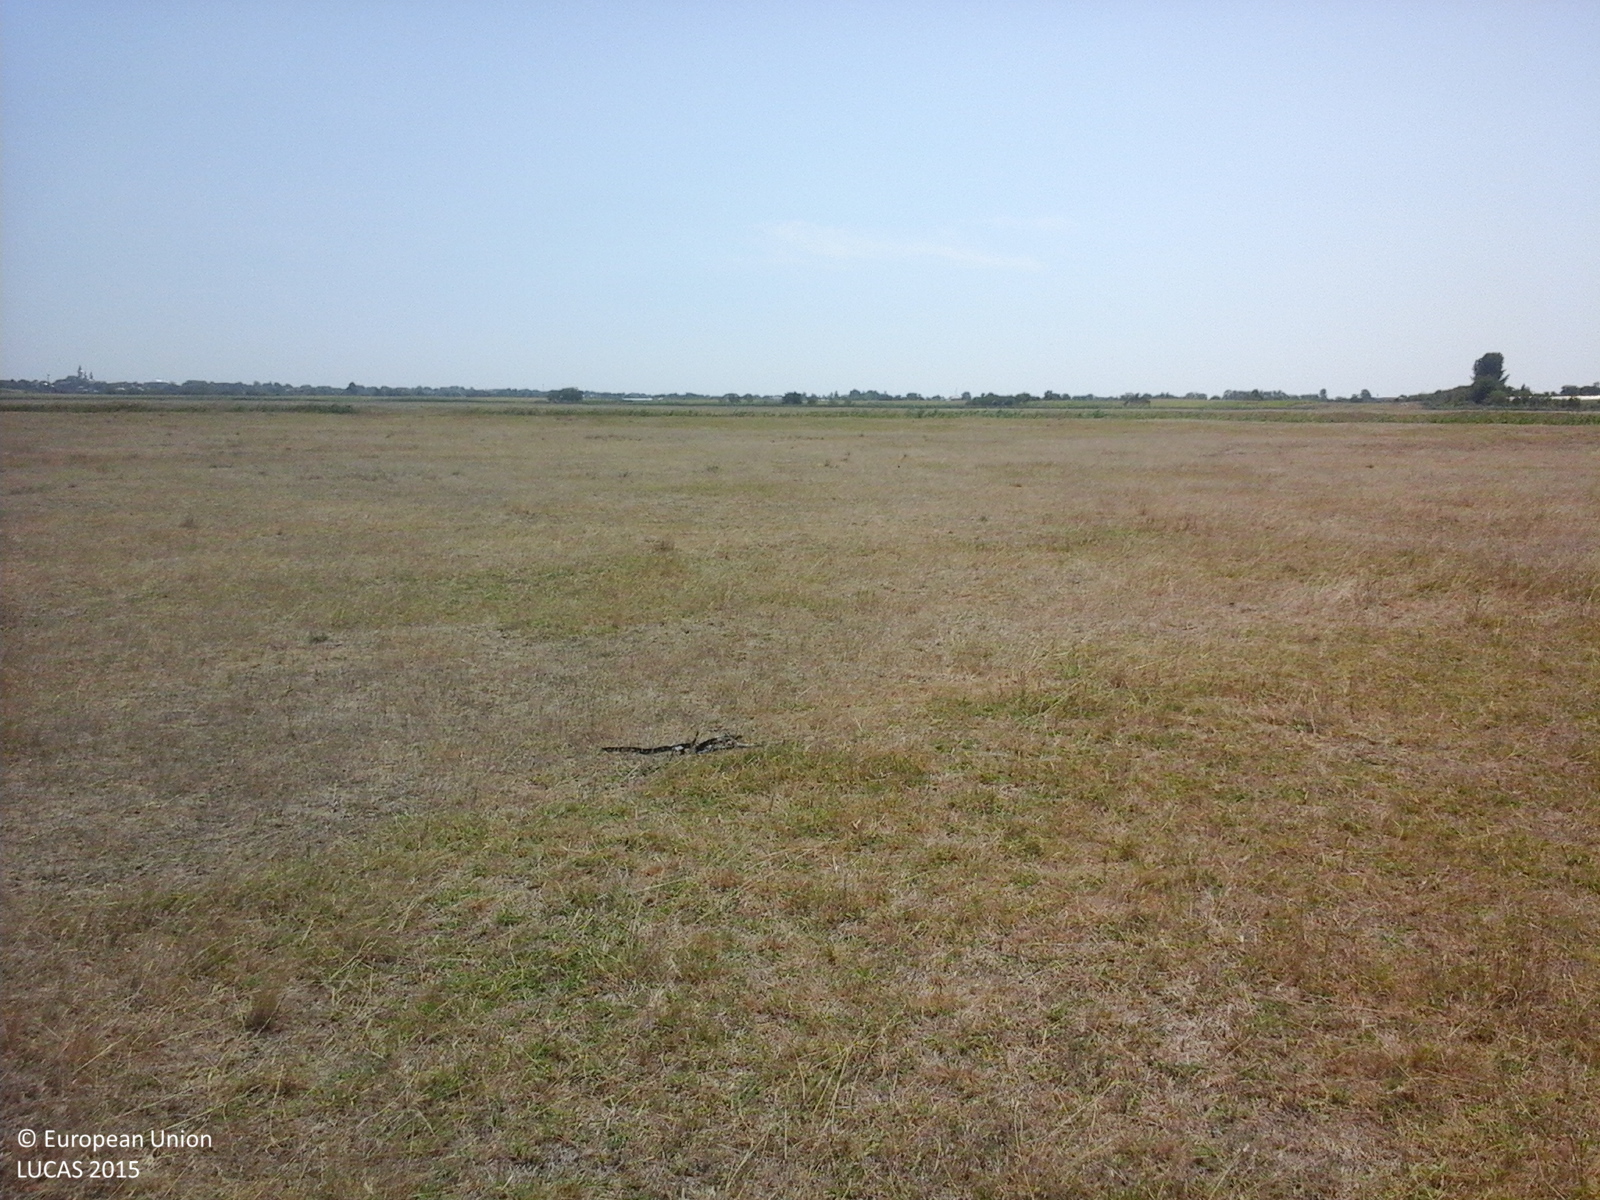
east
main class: Cropland
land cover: Temporary grasslands
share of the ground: > 75 %
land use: Agriculture (excluding fallow land and kitchen gardens)
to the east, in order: Temporary grasslands; Inland fresh running water
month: August
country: RO
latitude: 45.7287
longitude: 27.4633
